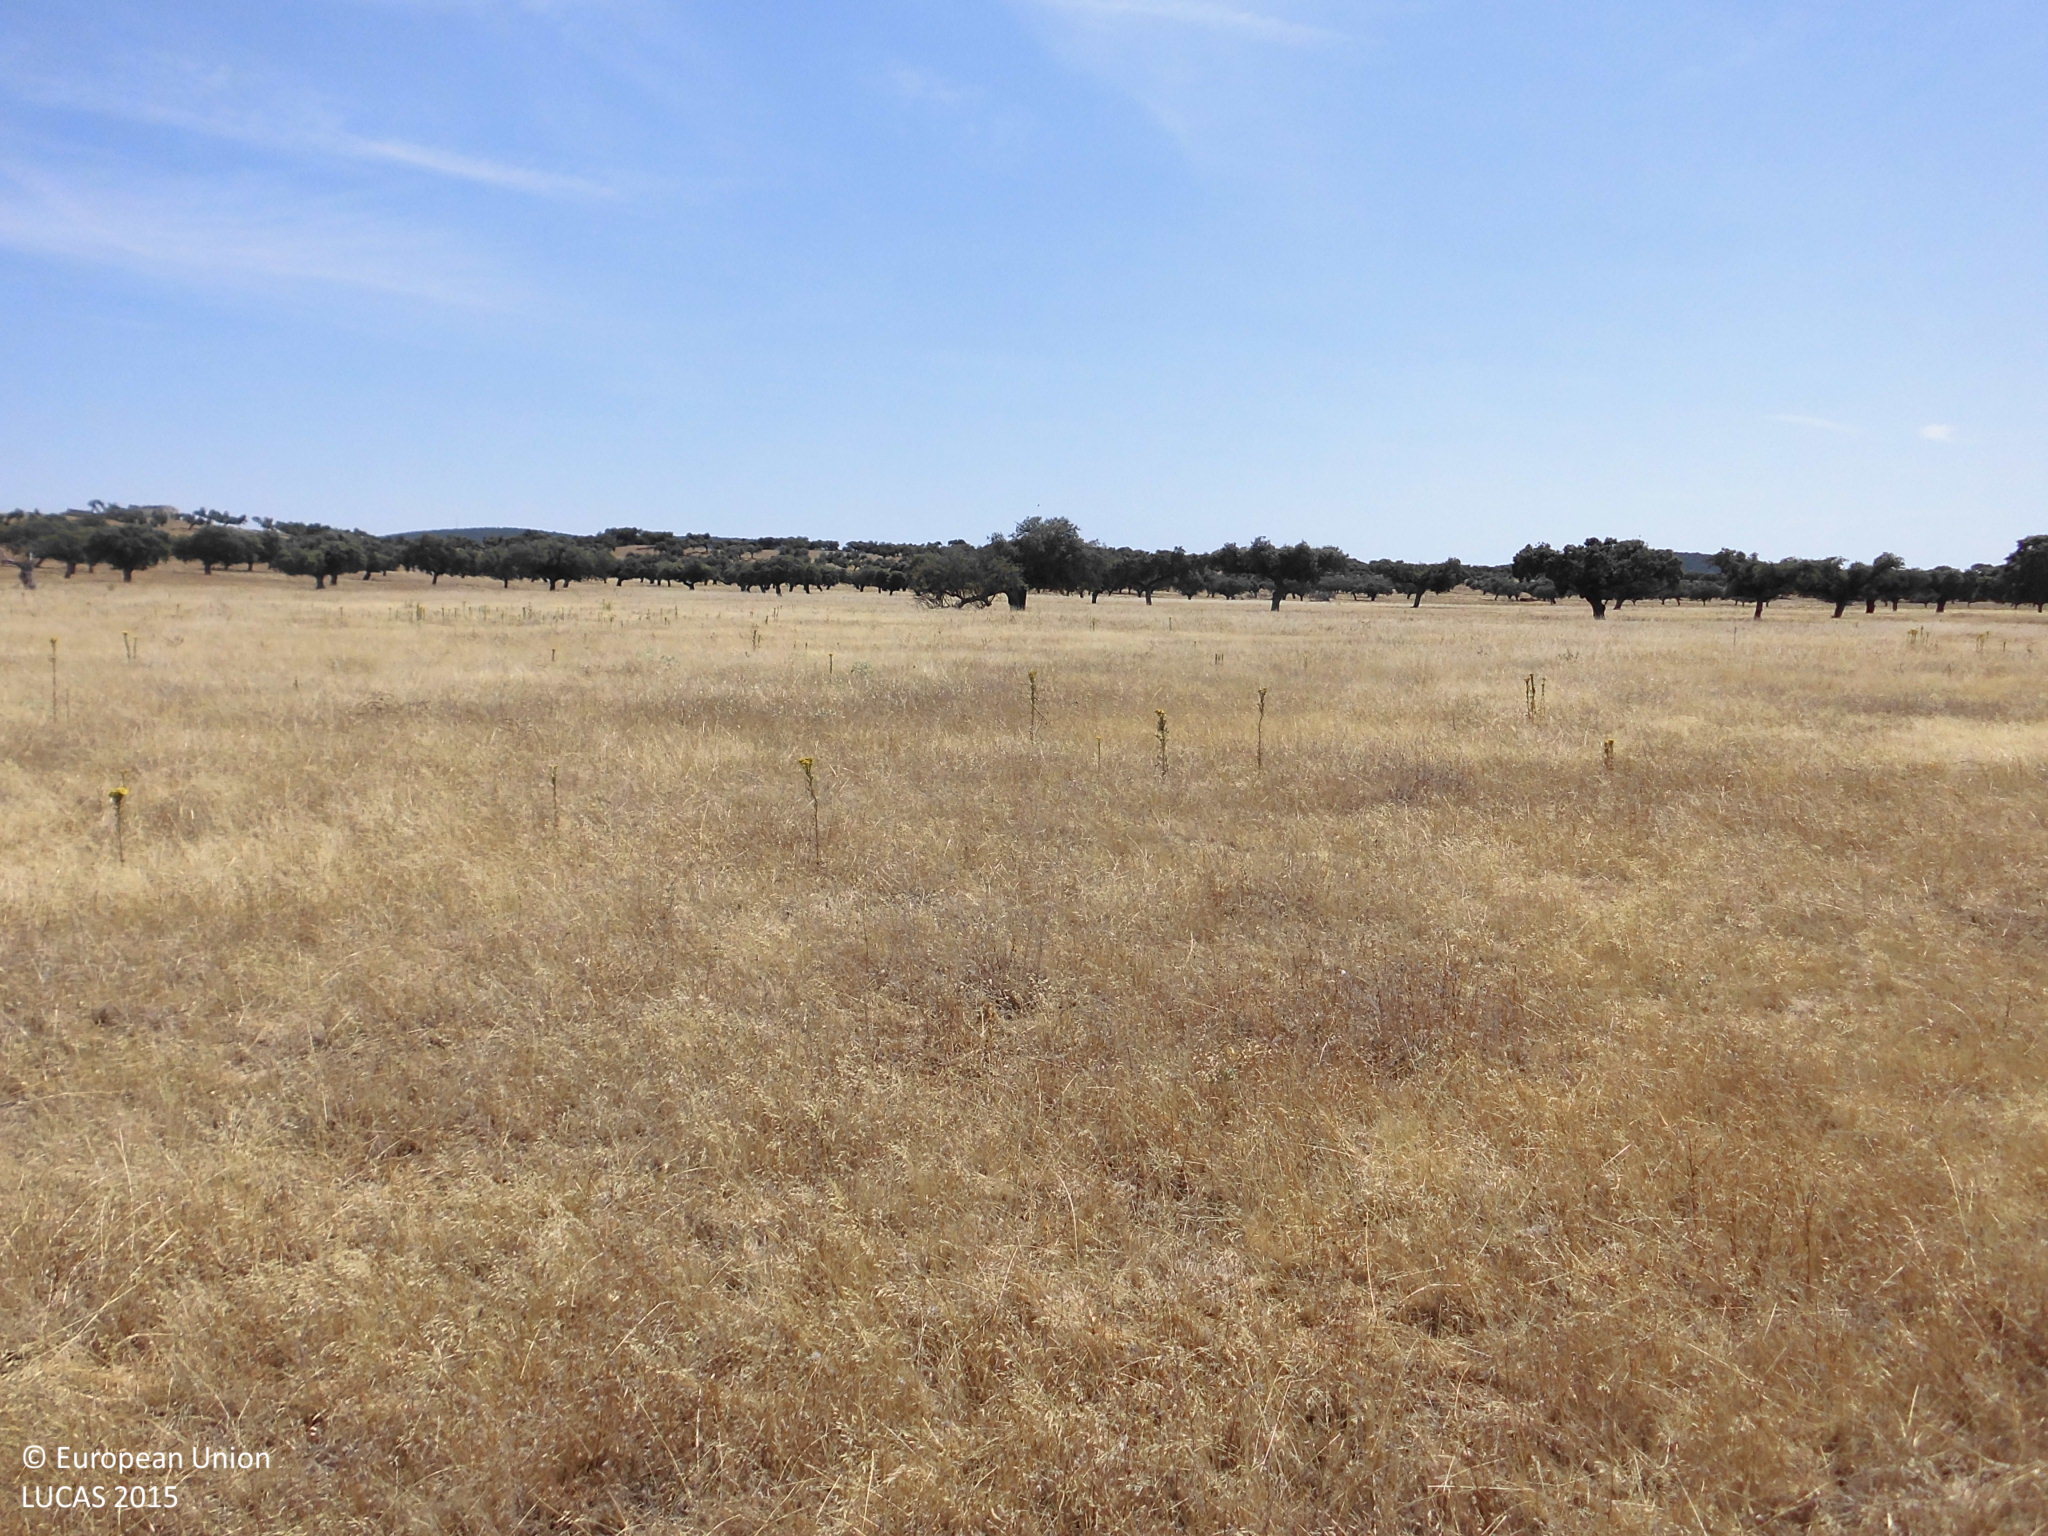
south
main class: Woodland
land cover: Broadleaved woodland
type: broadleaved evergreen forest
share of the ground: 10 - 25 %
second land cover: Grassland without tree/shrub cover
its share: > 75 %
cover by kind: herbaceous plants 90 %, broadleaved forest trees 10 %
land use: Forestry
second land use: Agriculture (excluding fallow land and kitchen gardens)
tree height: > 5 m
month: July
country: ES
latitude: 39.8817
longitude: -6.5542
